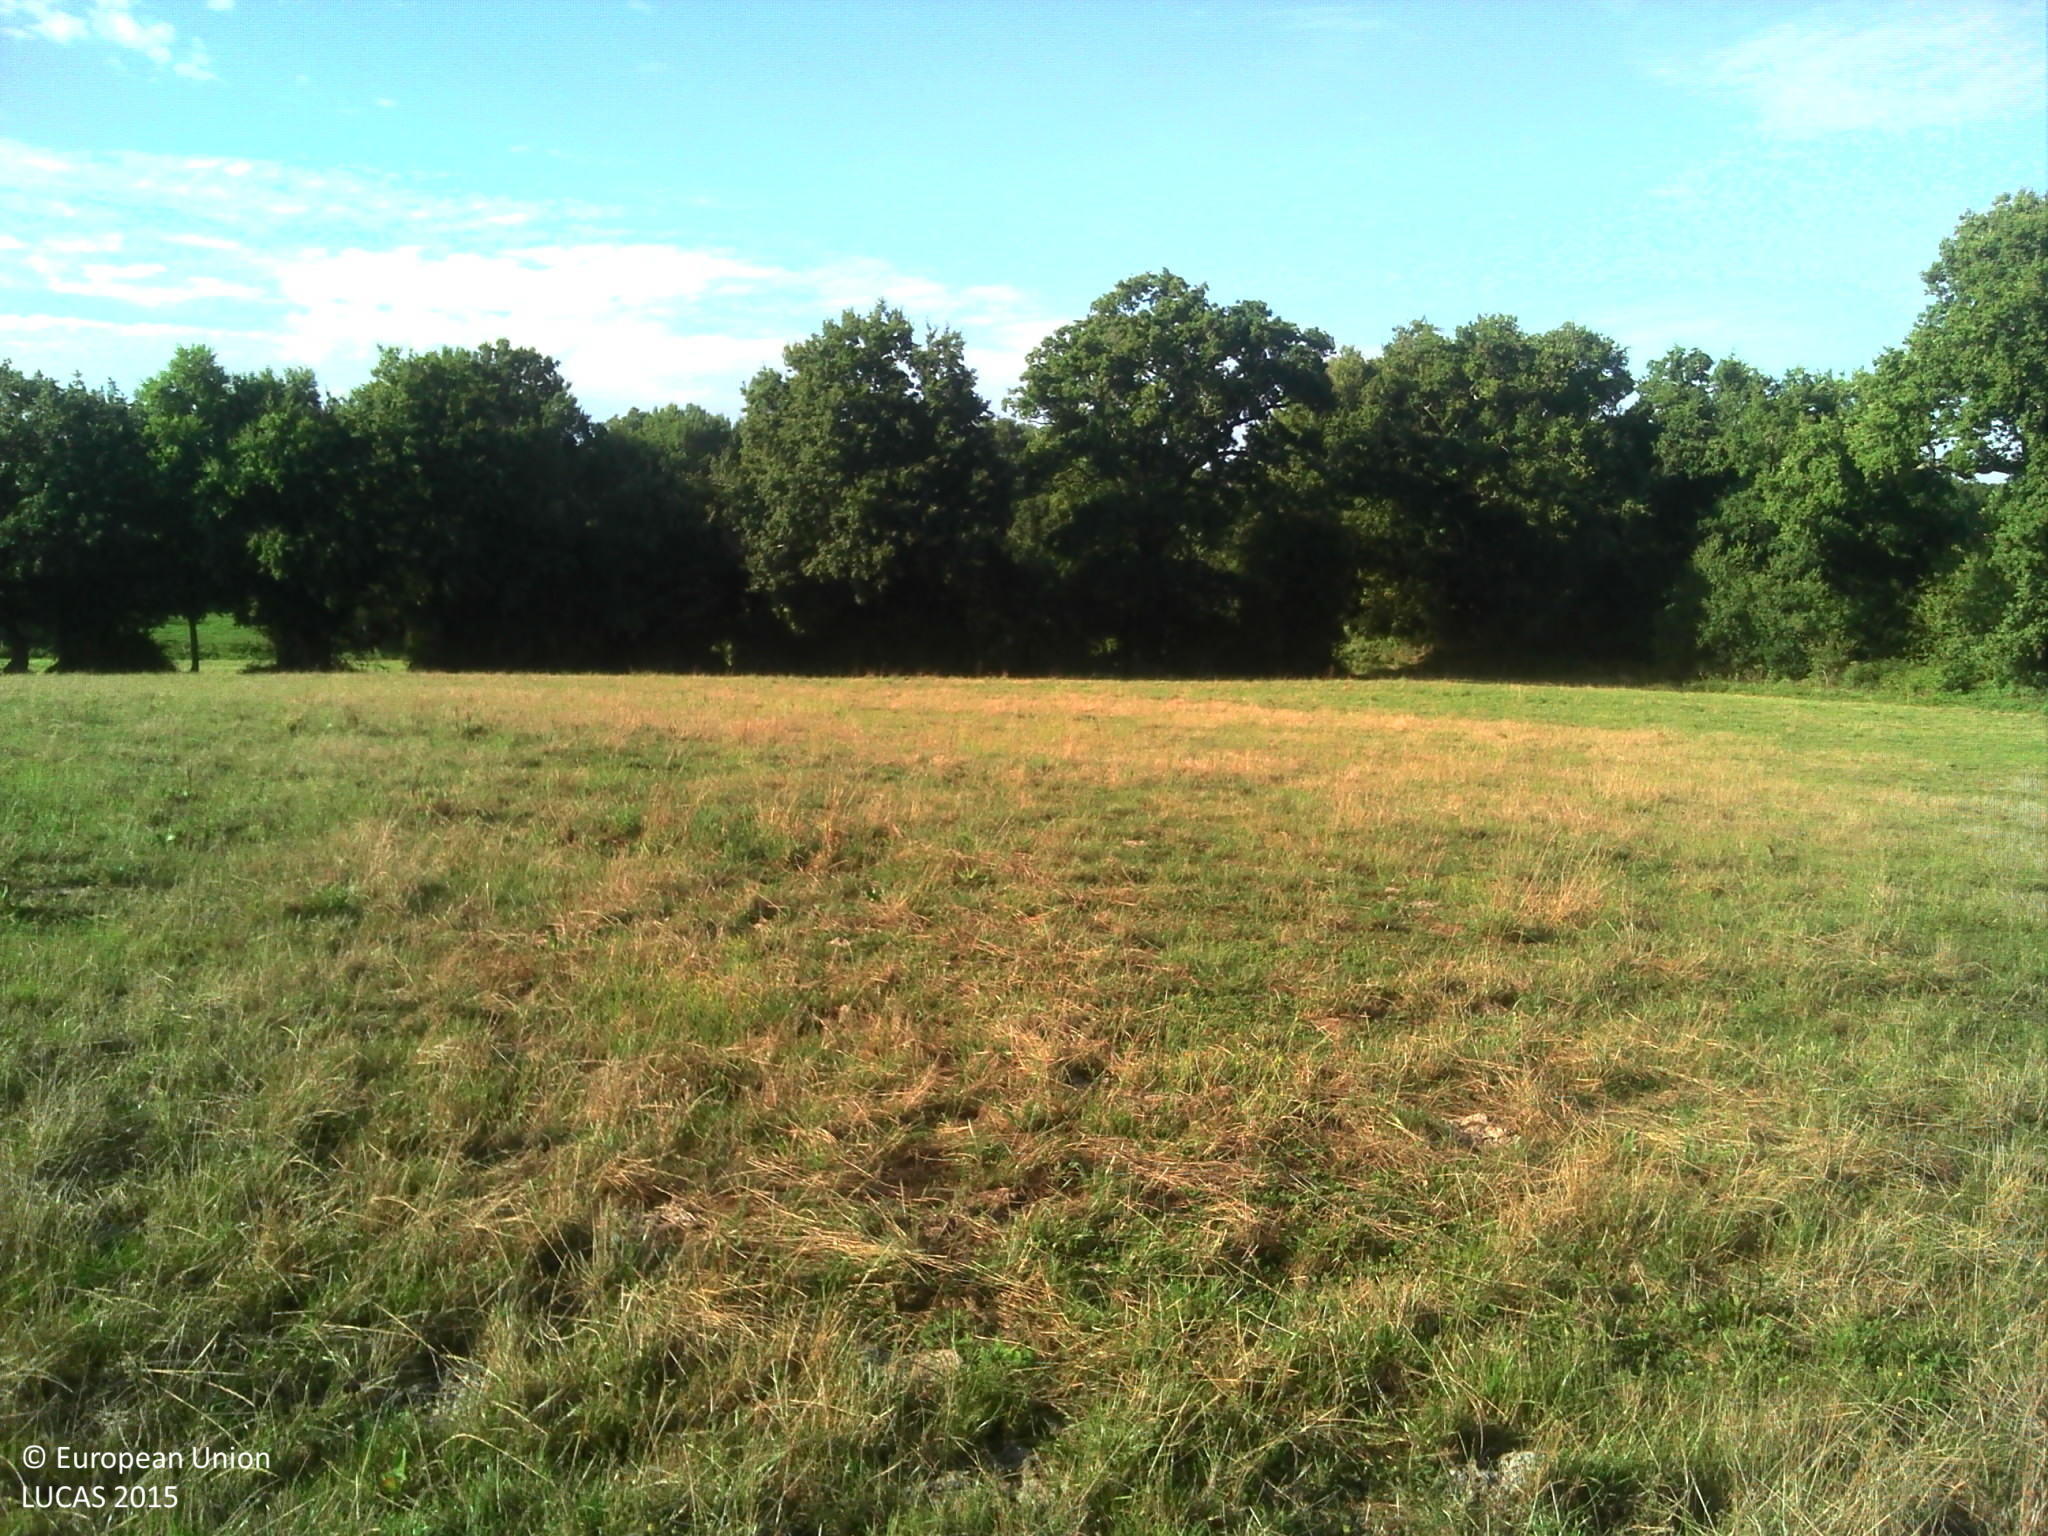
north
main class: Grassland
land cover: Grassland without tree/shrub cover
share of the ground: > 75 %
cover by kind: herbaceous plants 100 %
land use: Agriculture (excluding fallow land and kitchen gardens)
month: August
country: FR
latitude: 46.6515
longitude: -1.7097
